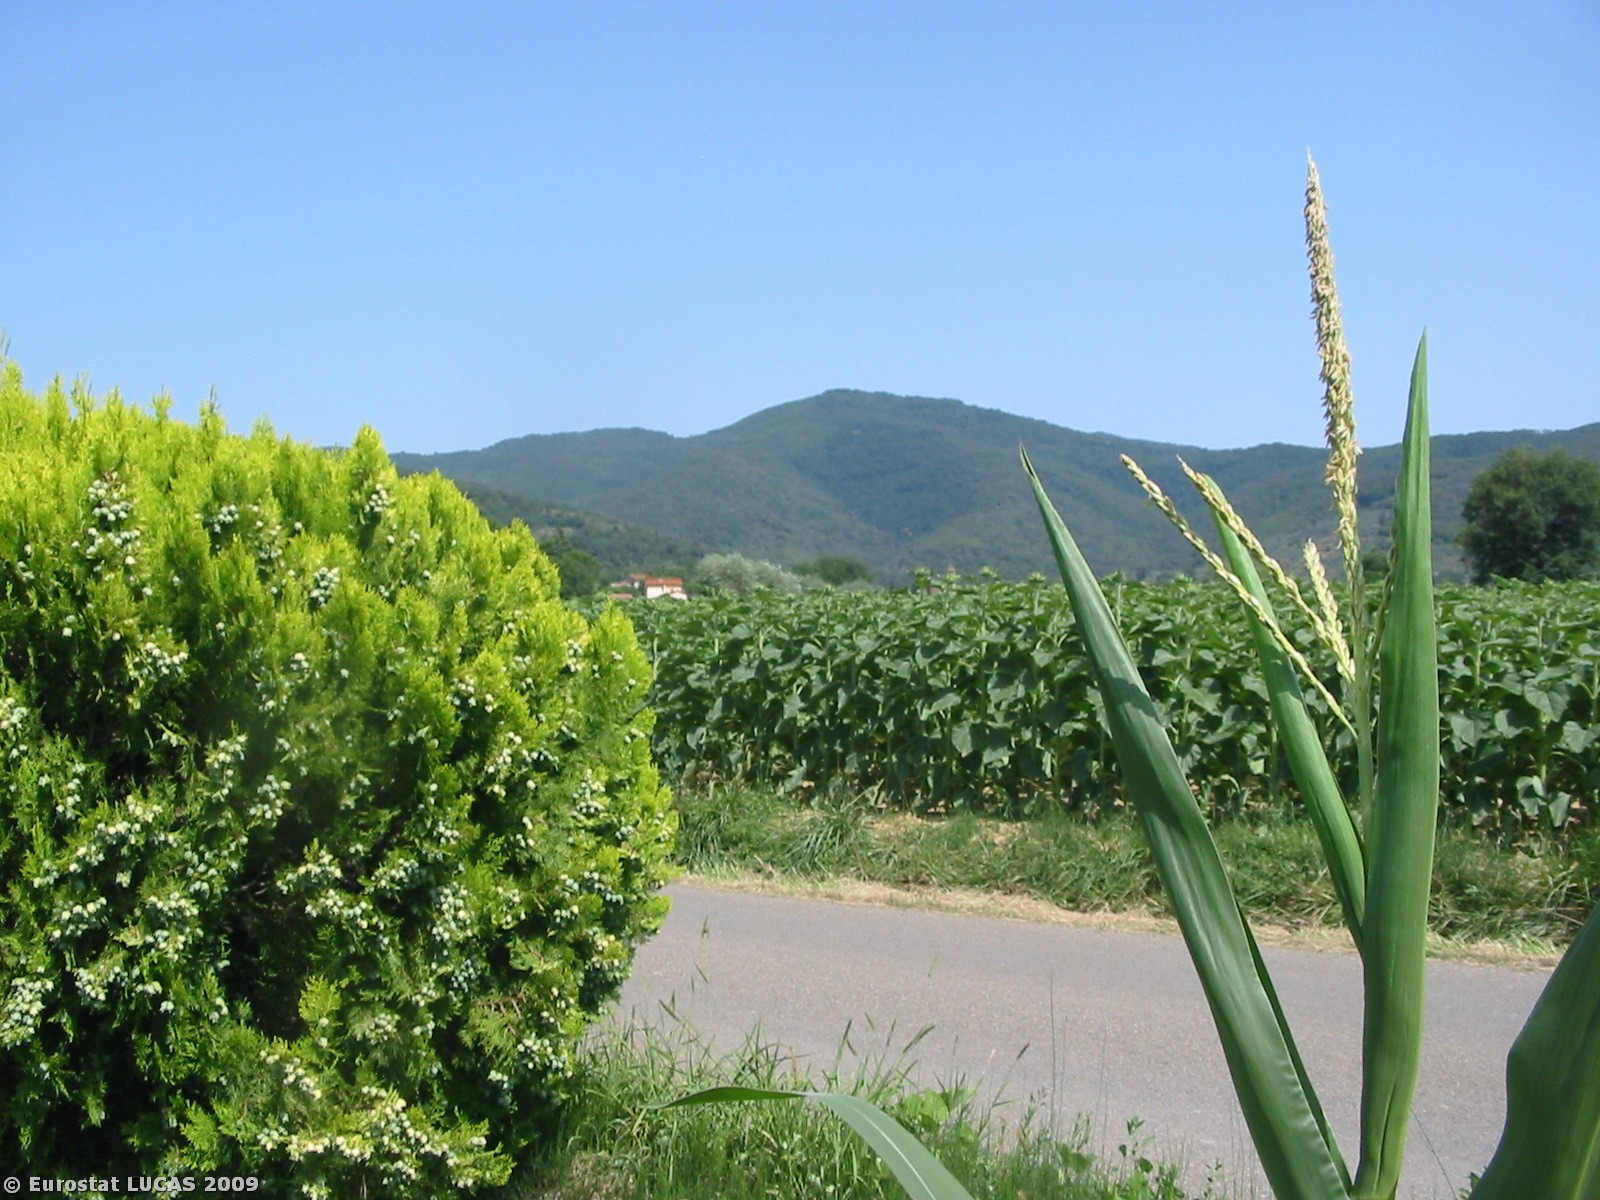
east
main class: Cropland
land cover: Maize
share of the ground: > 75 %
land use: Agriculture (excluding fallow land and kitchen gardens)
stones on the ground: < 10 %
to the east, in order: Maize; Grass margins; Tomatoes; Grass margins; Paved roads, cycling and walking lanes; Grass margins; Ditches and canals; Sunflower; Vineyards; Bare land; Spontaneously vegetated surfaces; Tomatoes
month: July
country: IT
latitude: 43.3219
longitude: 11.9306
